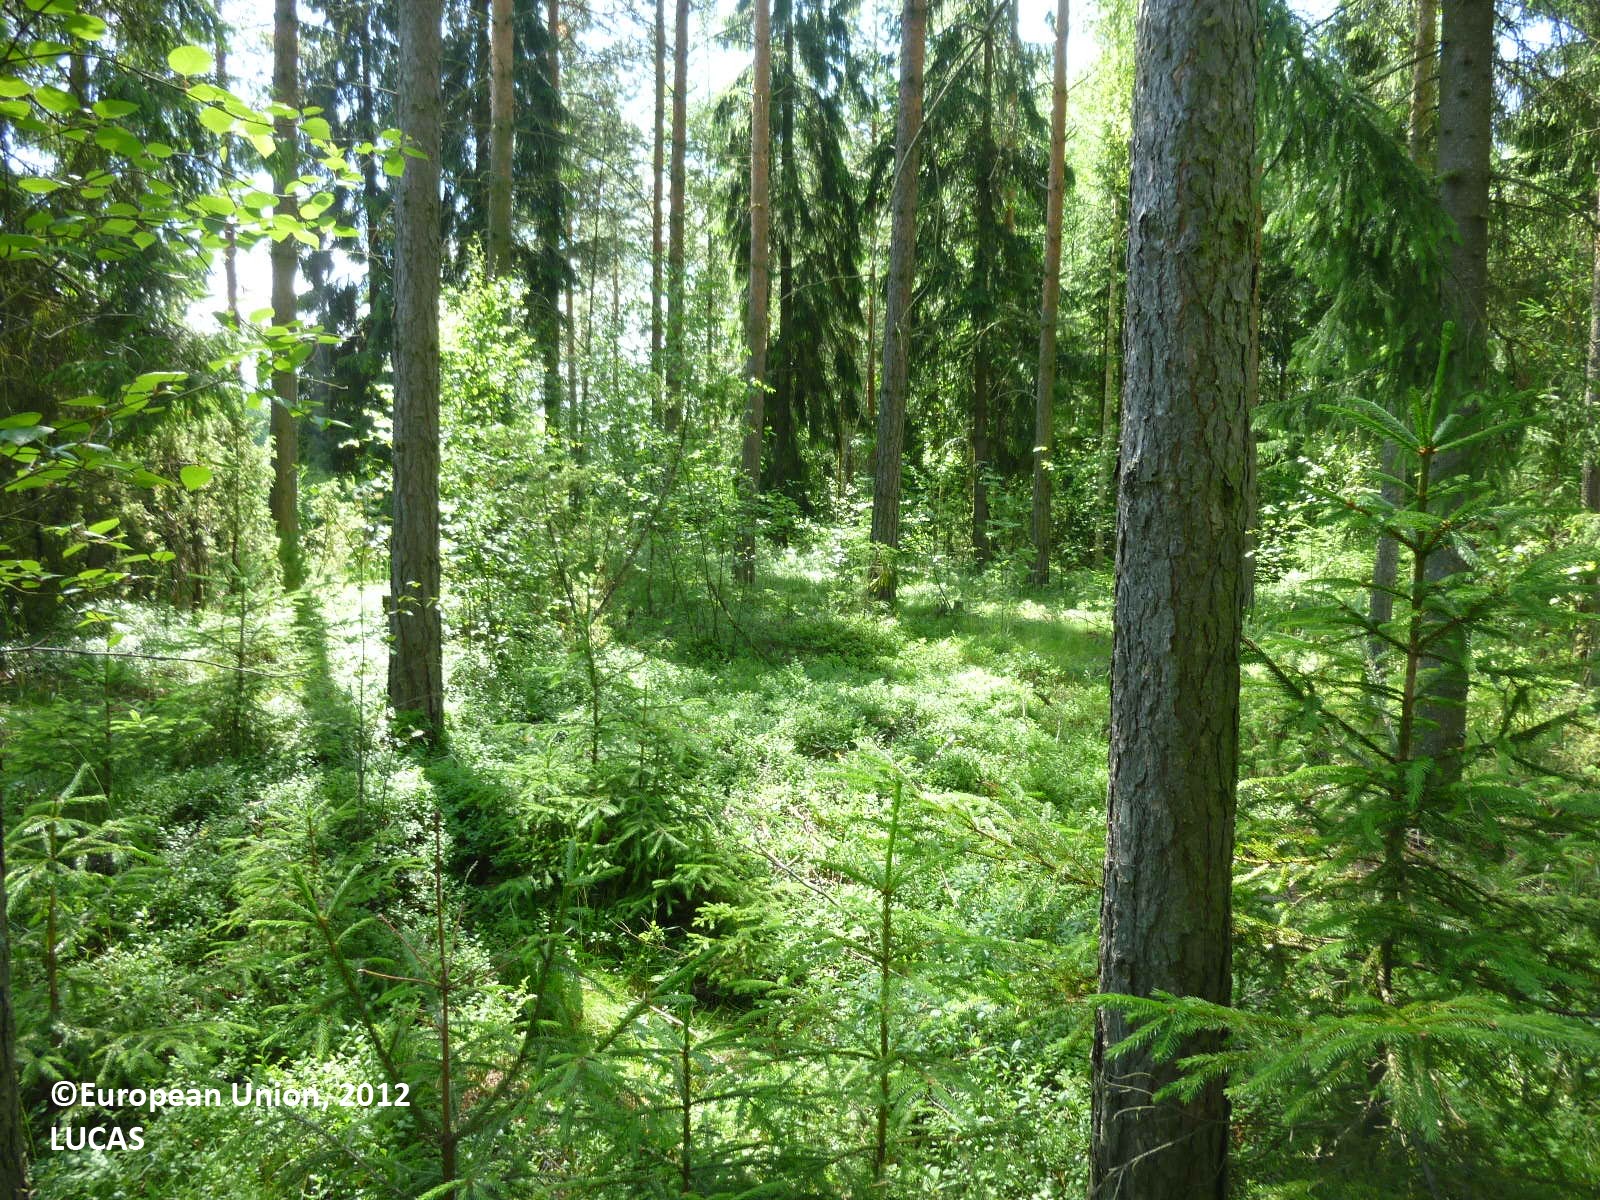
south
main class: Woodland
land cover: Other coniferous woodland
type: boreal forest
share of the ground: > 75 %
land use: Forestry
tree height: > 5 m
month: July
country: FI
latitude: 61.3533
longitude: 22.1199
